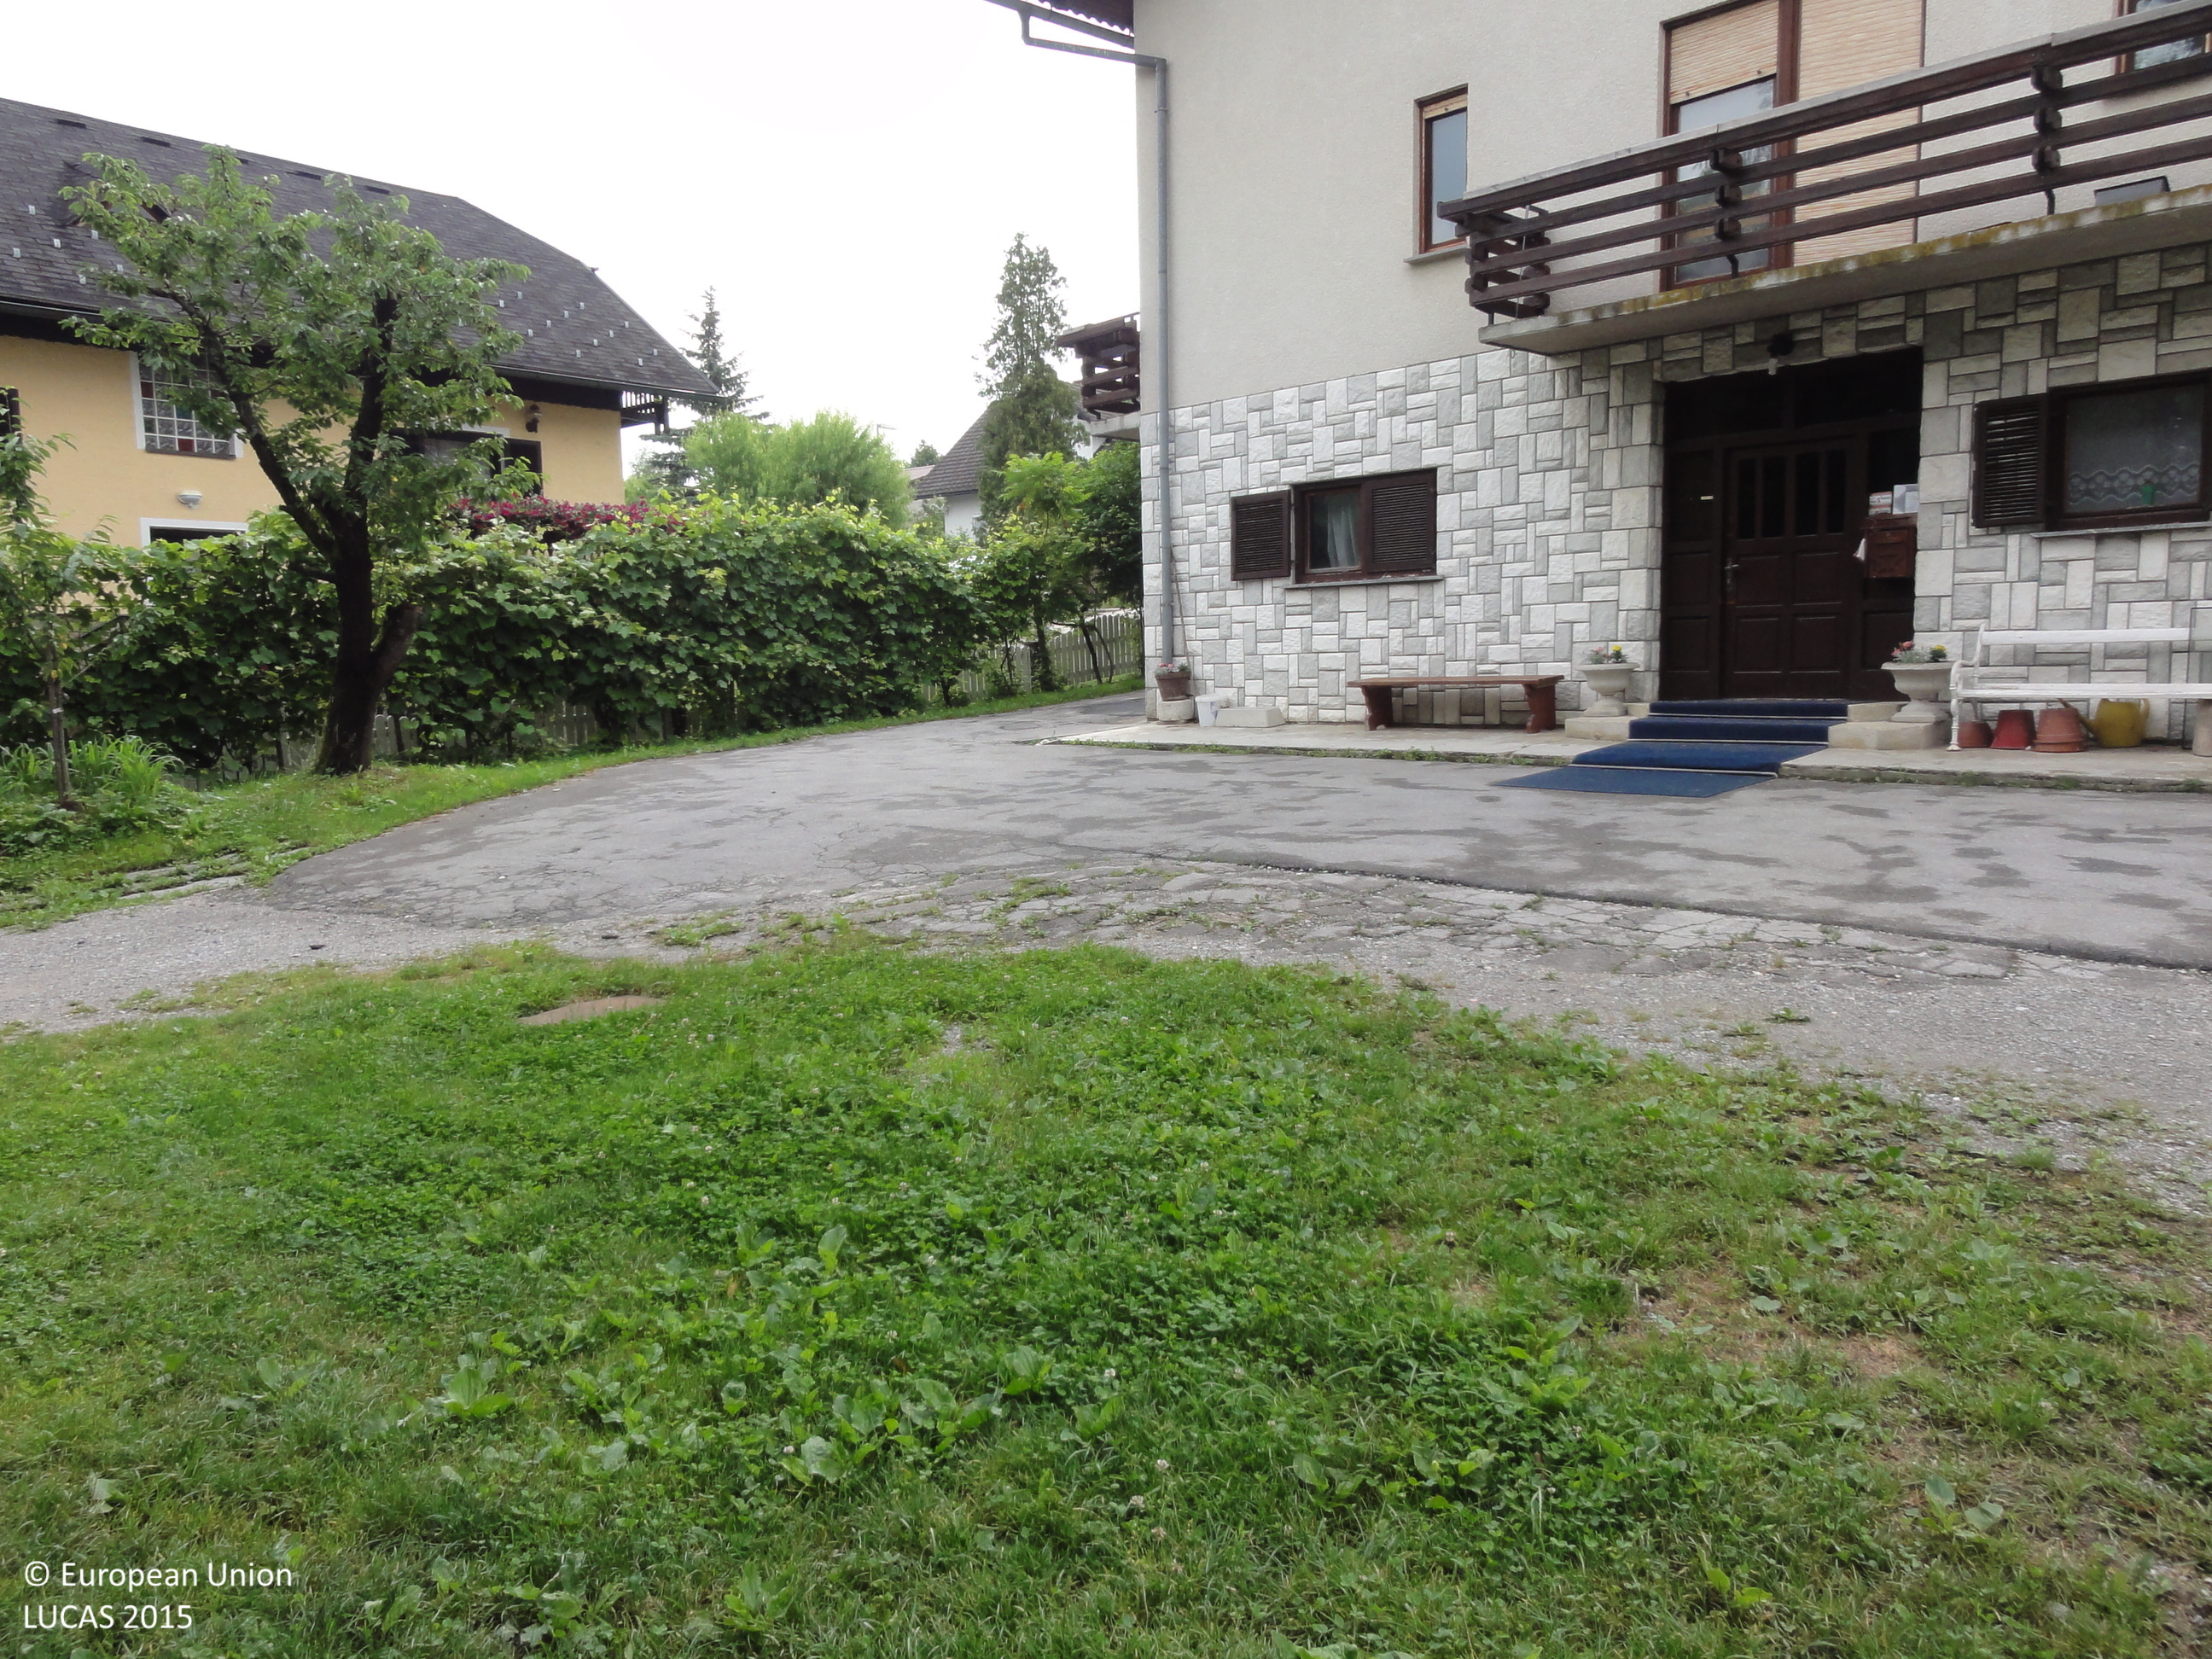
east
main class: Grassland
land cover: Grassland without tree/shrub cover
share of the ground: > 75 %
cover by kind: herbaceous plants 100 %
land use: Residential
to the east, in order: Rivers and streams; Abandoned hedges; Grassland without tree/shrub cover; Artificial constructions in urban areas
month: June
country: SI
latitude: 46.2273
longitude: 15.5084
